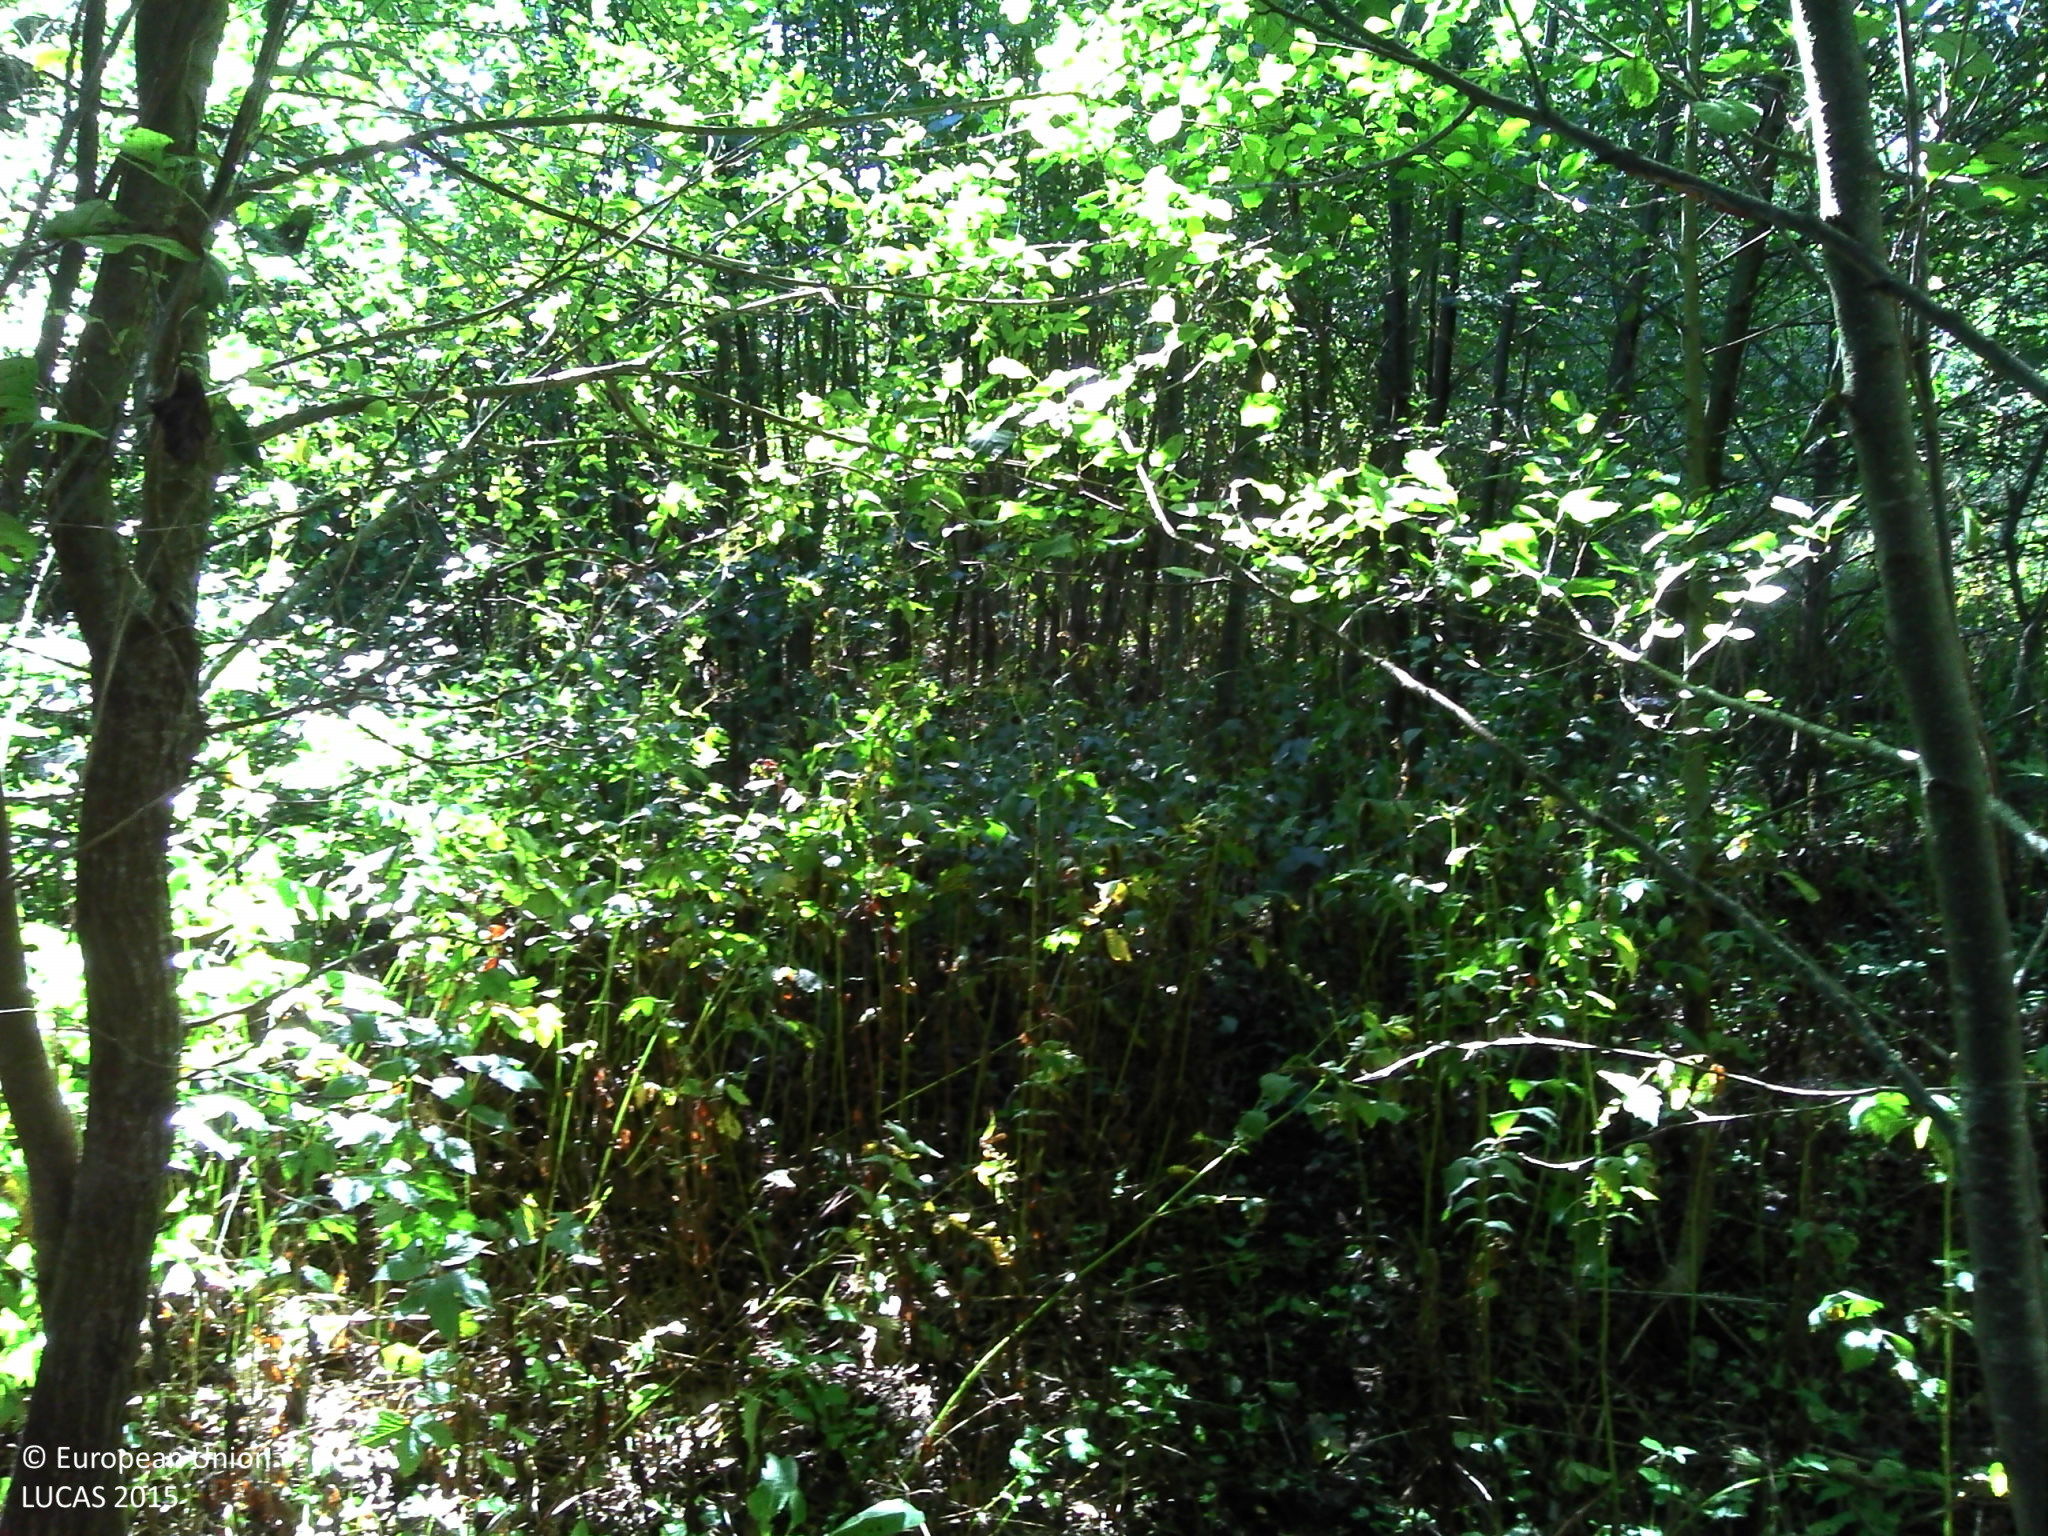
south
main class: Woodland
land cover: Broadleaved woodland
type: non-riverine alder, birch or aspen forest
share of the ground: > 75 %
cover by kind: broadleaved forest trees 80 %, herbaceous plants 10 %, shrubs 5 %, unconsolidated bare surface 5 %
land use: Semi-natural and natural areas not in use
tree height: > 5 m
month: September
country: FR
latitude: 45.8963
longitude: 2.8713
